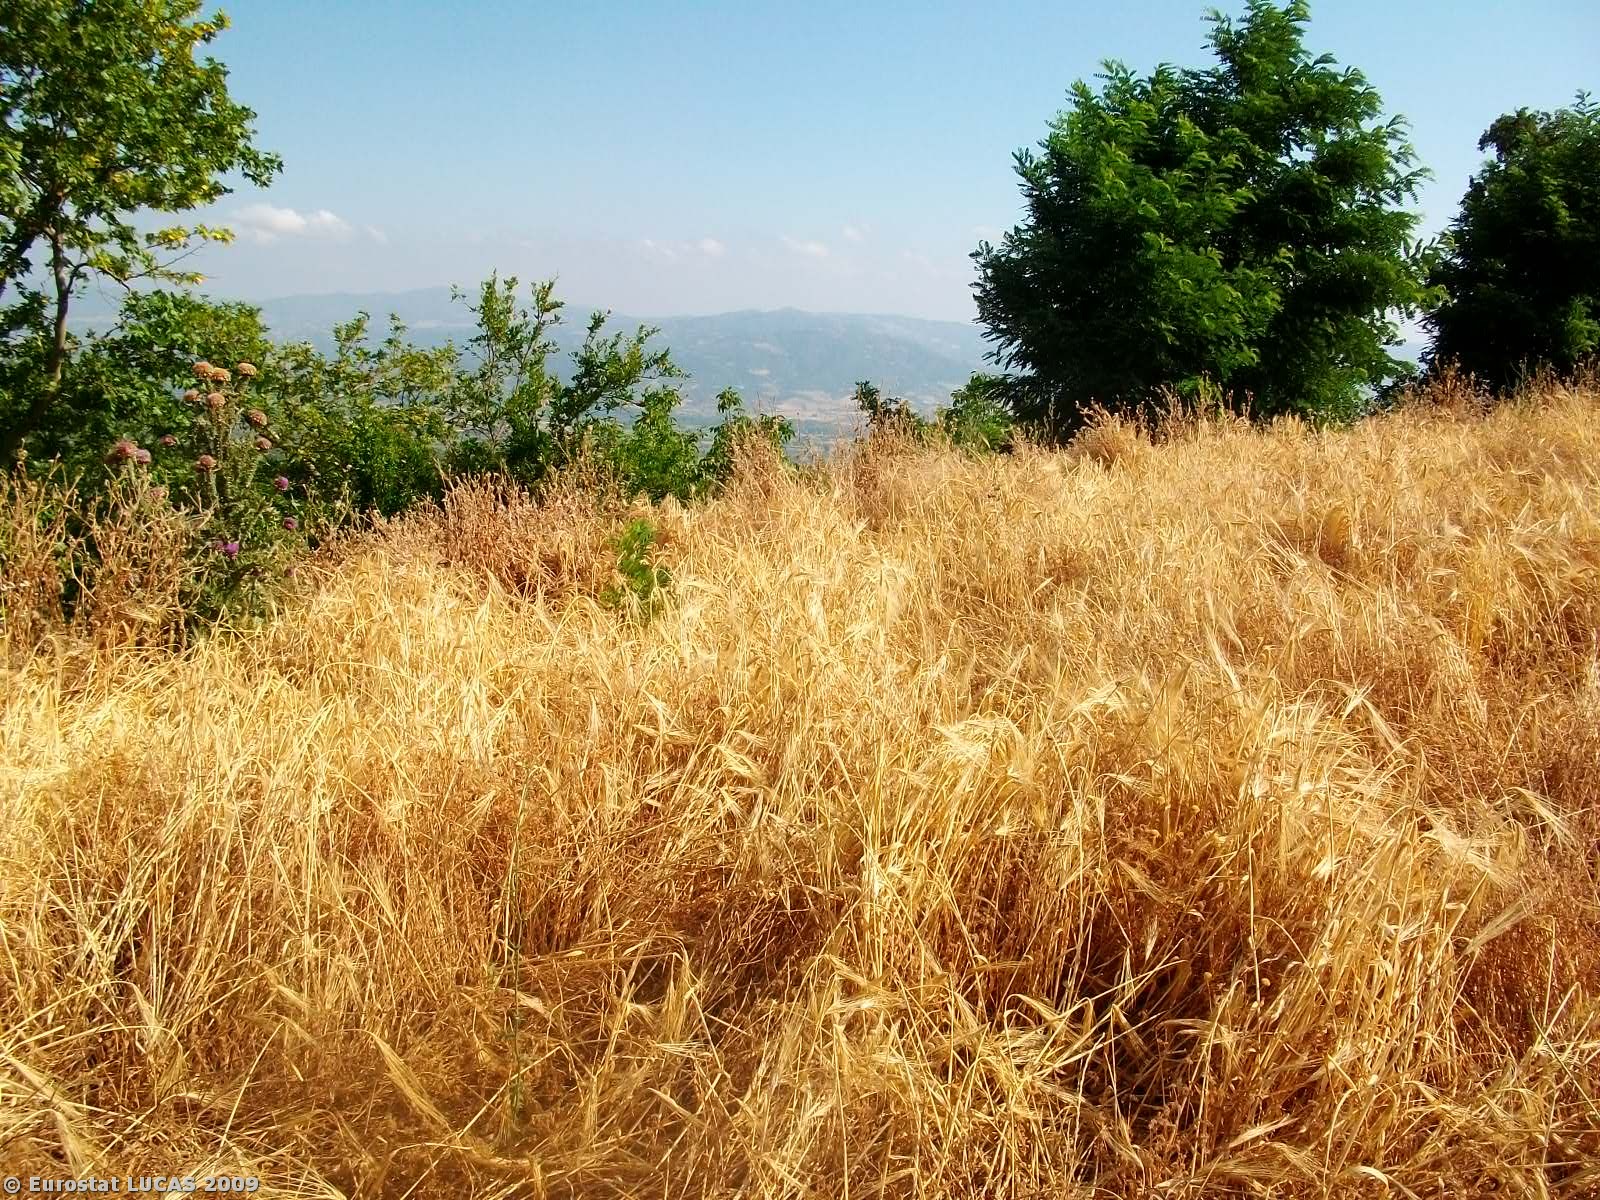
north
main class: Cropland
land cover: Common wheat
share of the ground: 25 - 50 %
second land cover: Grassland without tree/shrub cover
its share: 25 - 50 %
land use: Agriculture (excluding fallow land and kitchen gardens)
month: June
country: GR
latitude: 38.8742
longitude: 22.2544
